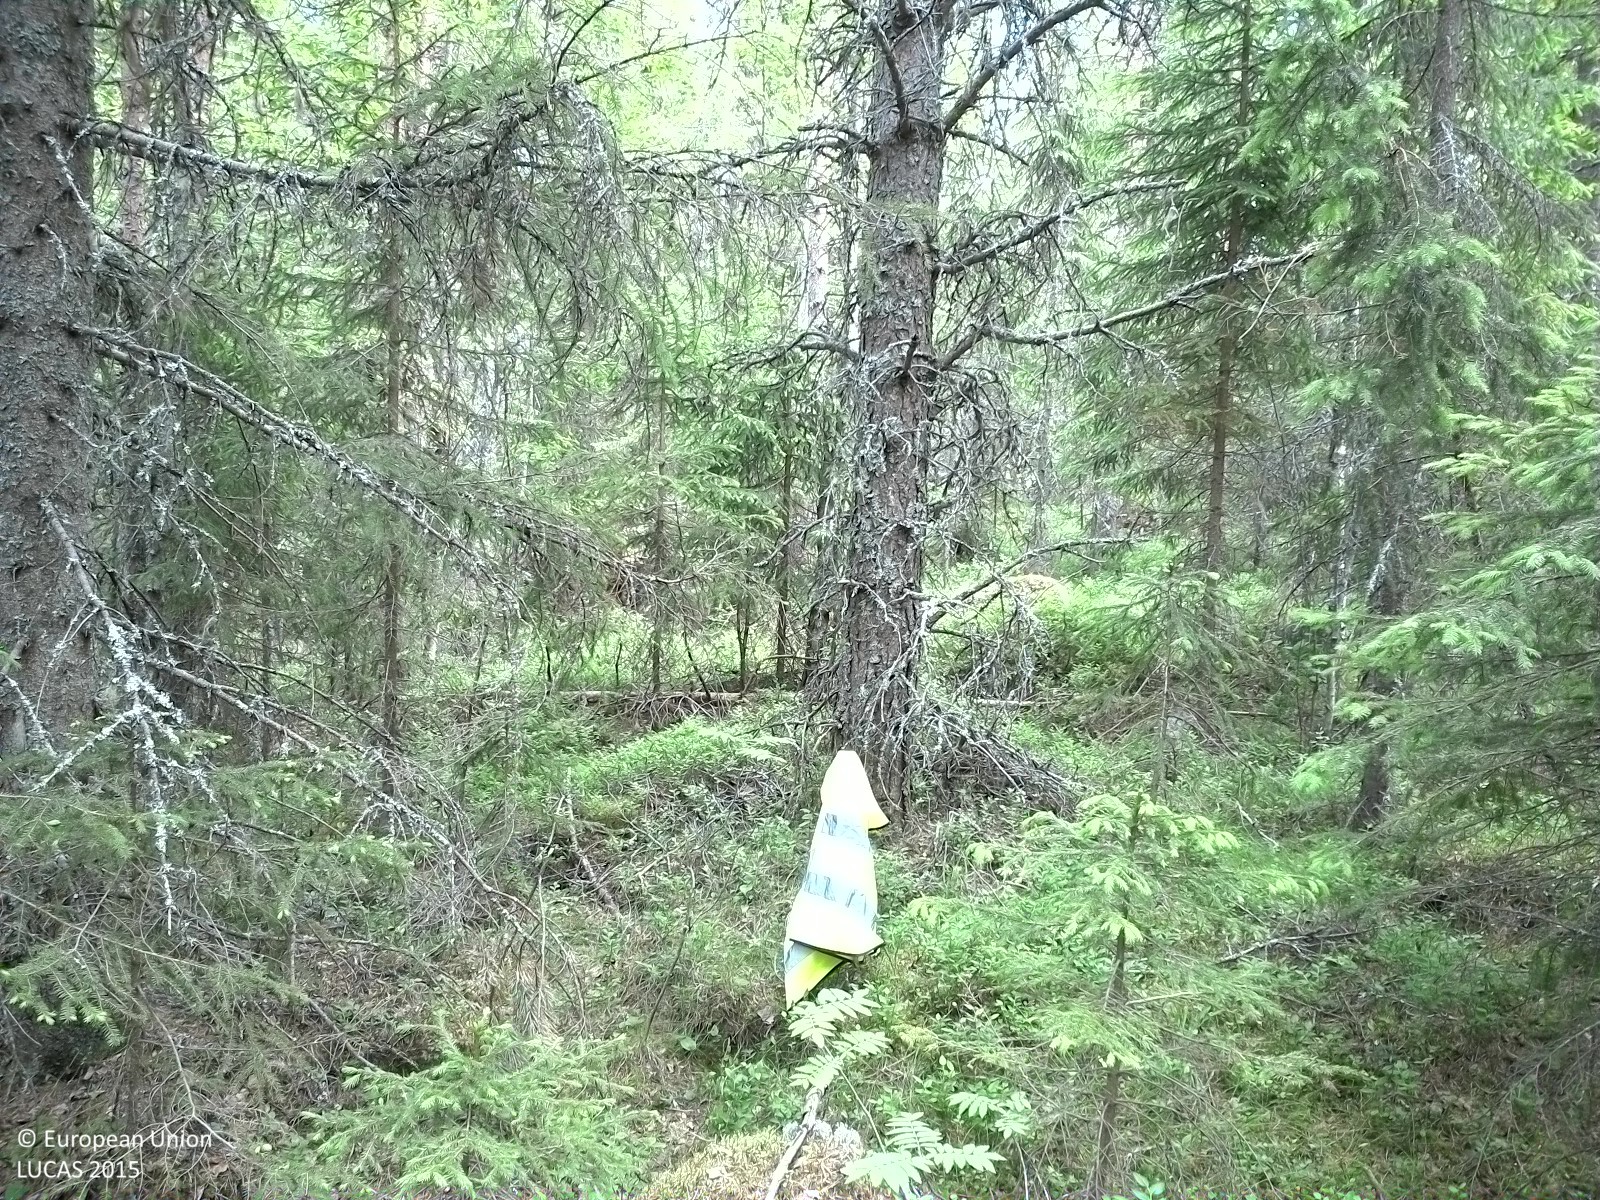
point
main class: Woodland
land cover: Spruce dominated mixed woodland
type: boreal forest
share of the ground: 50 - 75 %
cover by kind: coniferous forest trees 40 %, shrubs 30 %, broadleaved forest trees 25 %, herbaceous plants 5 %
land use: Forestry
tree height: > 5 m
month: July
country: SE
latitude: 62.1801
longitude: 16.9534
